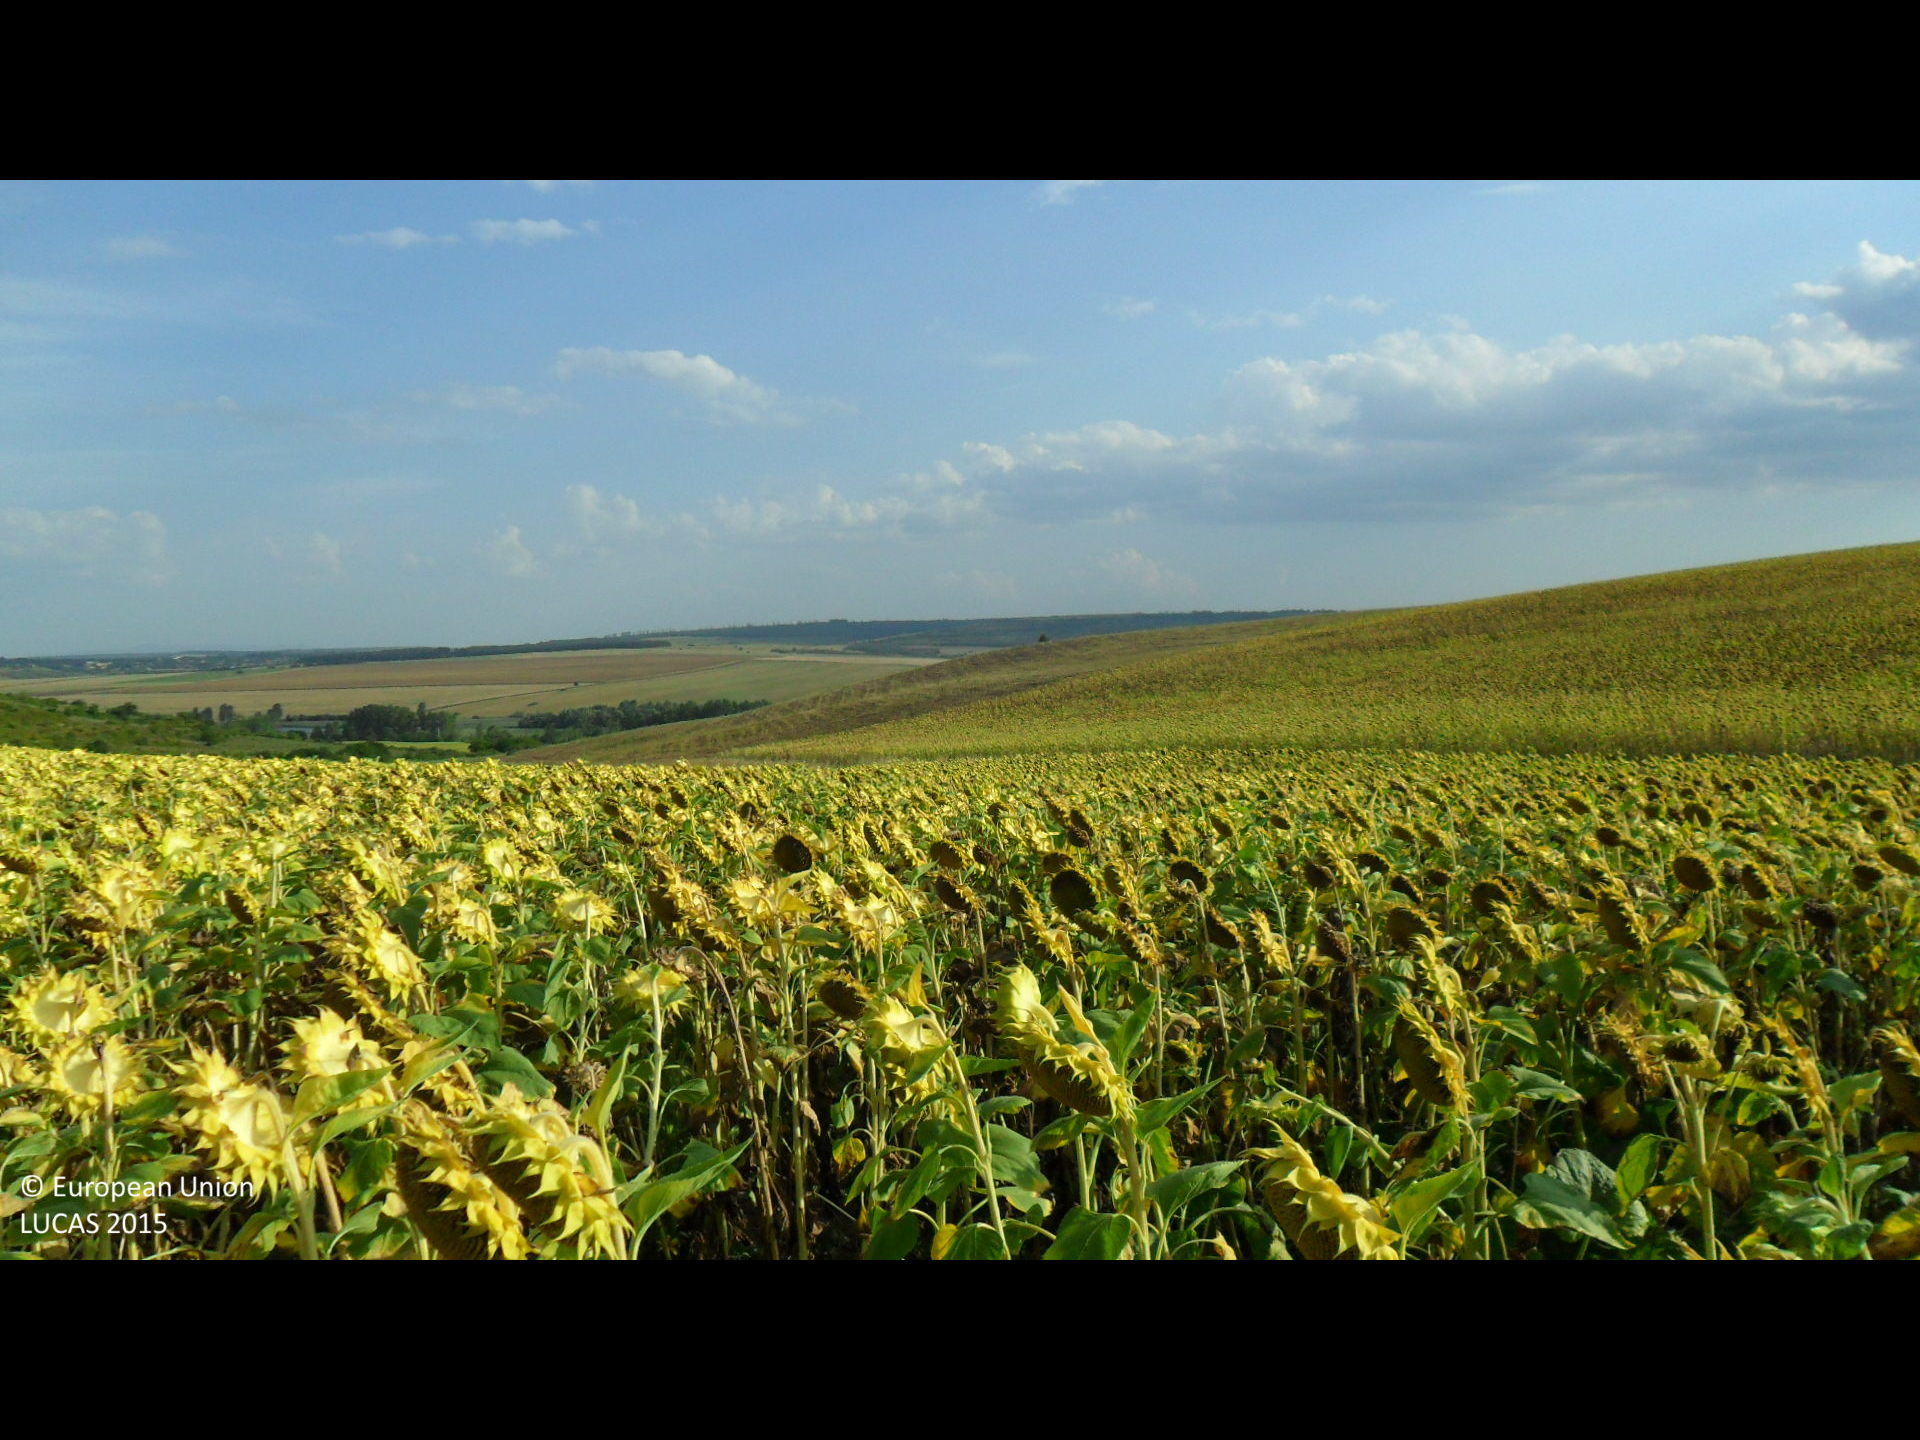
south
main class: Cropland
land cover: Sunflower
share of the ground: > 75 %
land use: Agriculture (excluding fallow land and kitchen gardens)
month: August
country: BG
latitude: 43.3692
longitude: 26.1502
